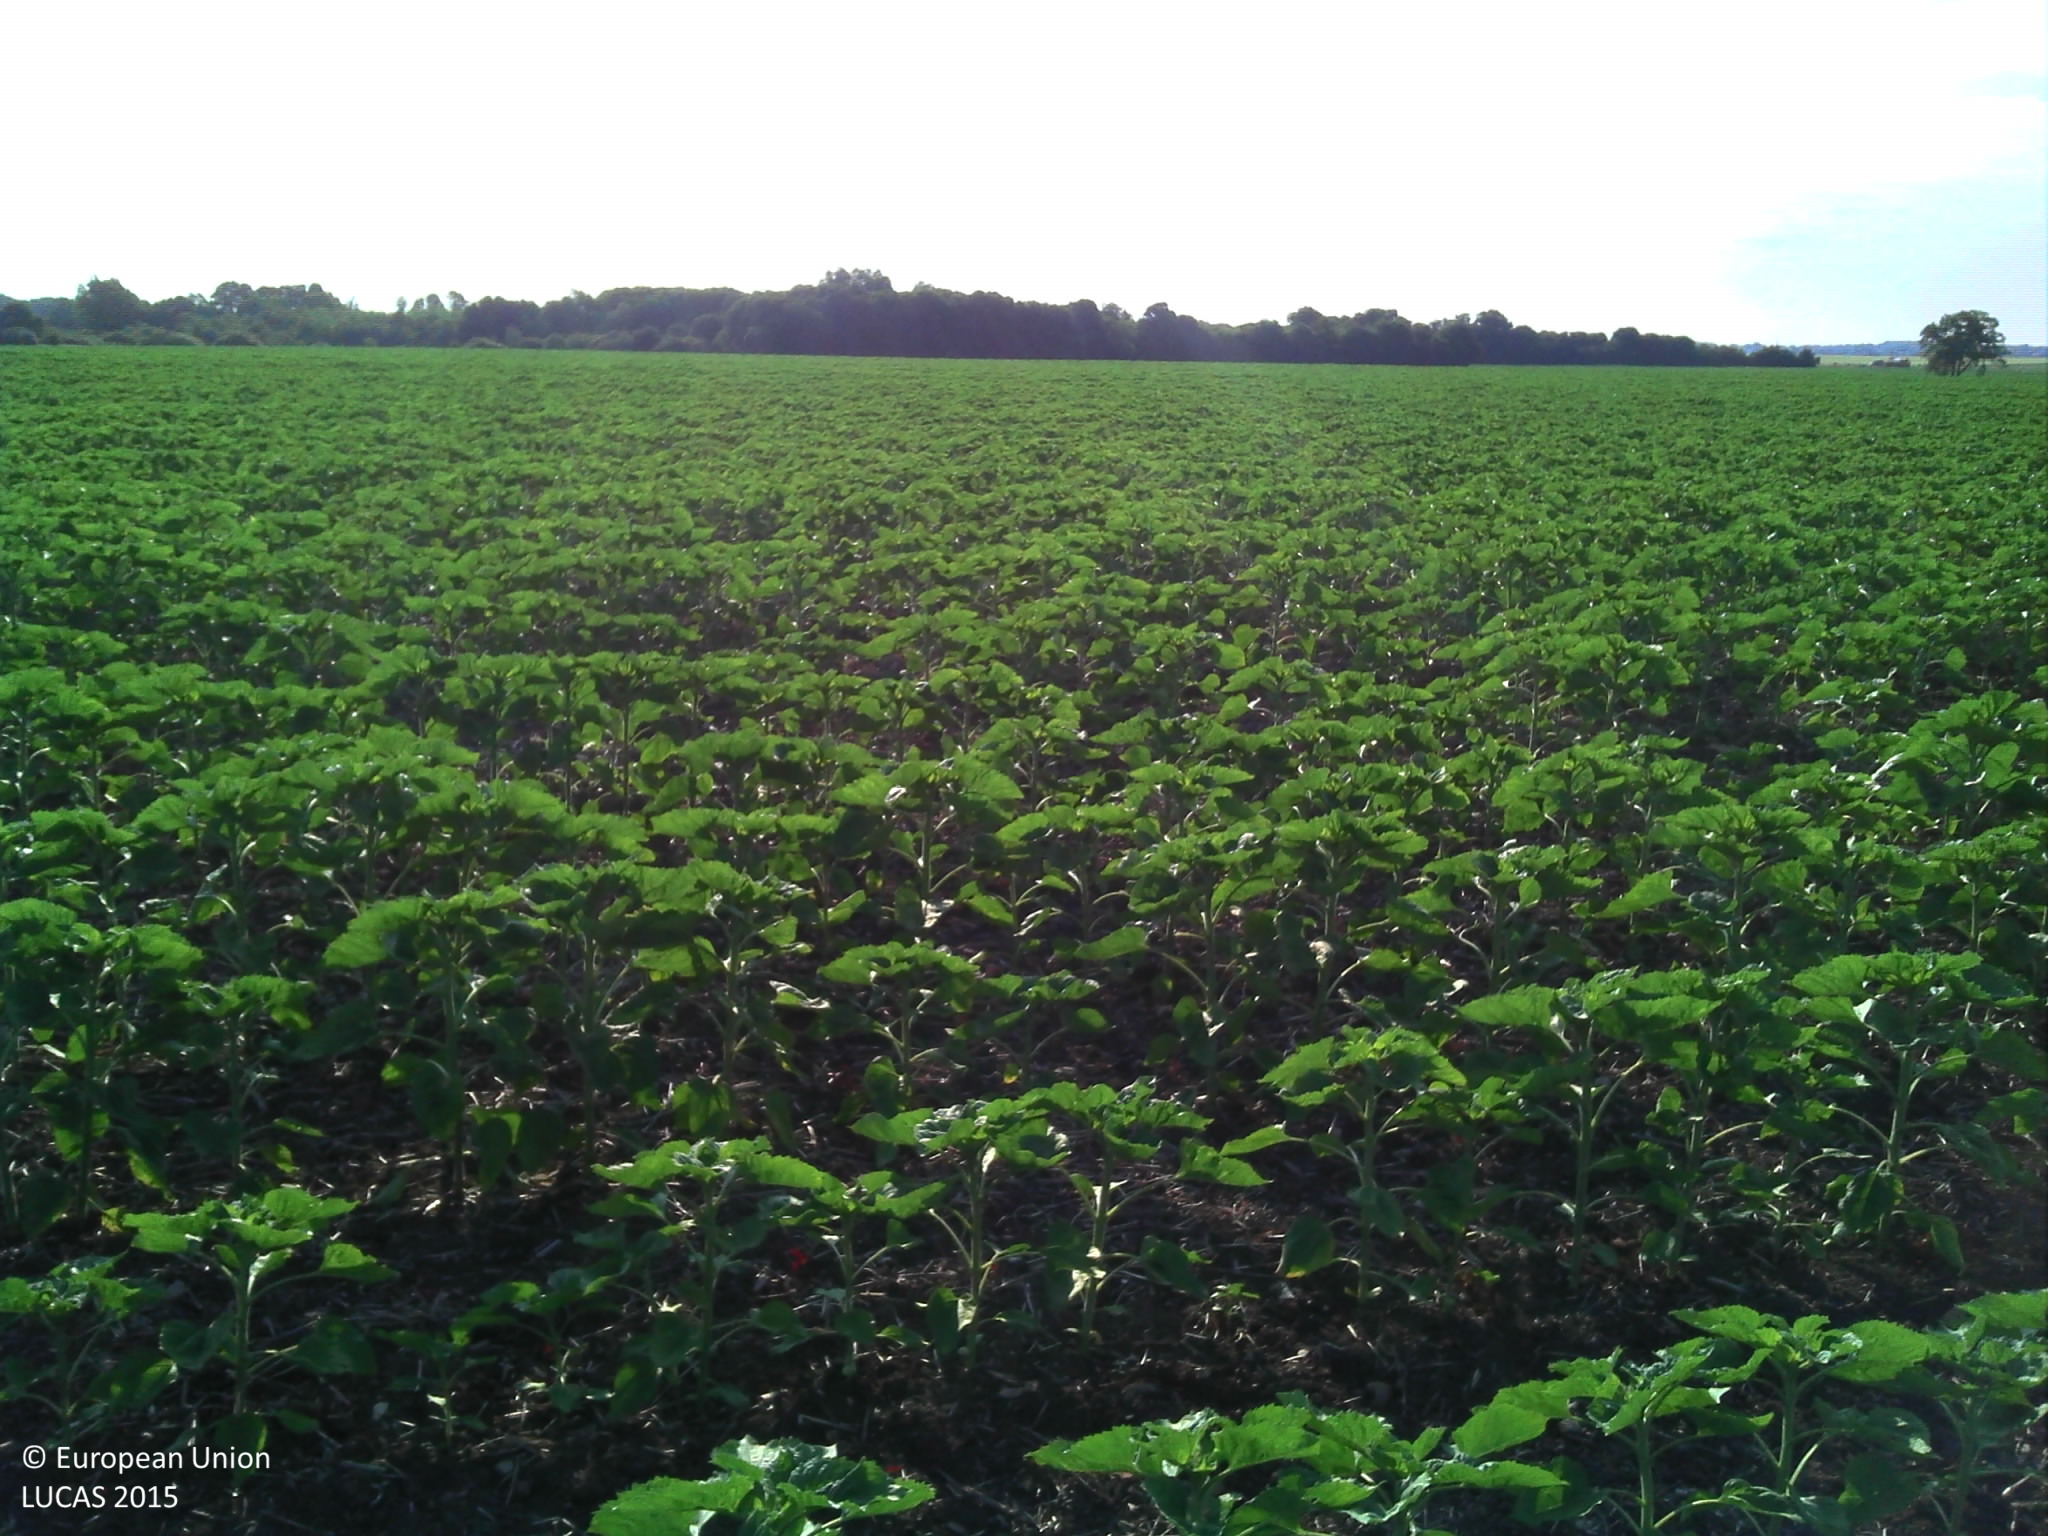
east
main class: Cropland
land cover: Sunflower
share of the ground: > 75 %
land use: Agriculture (excluding fallow land and kitchen gardens)
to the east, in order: Sunflower
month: June
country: FR
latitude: 46.8763
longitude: 2.6600
